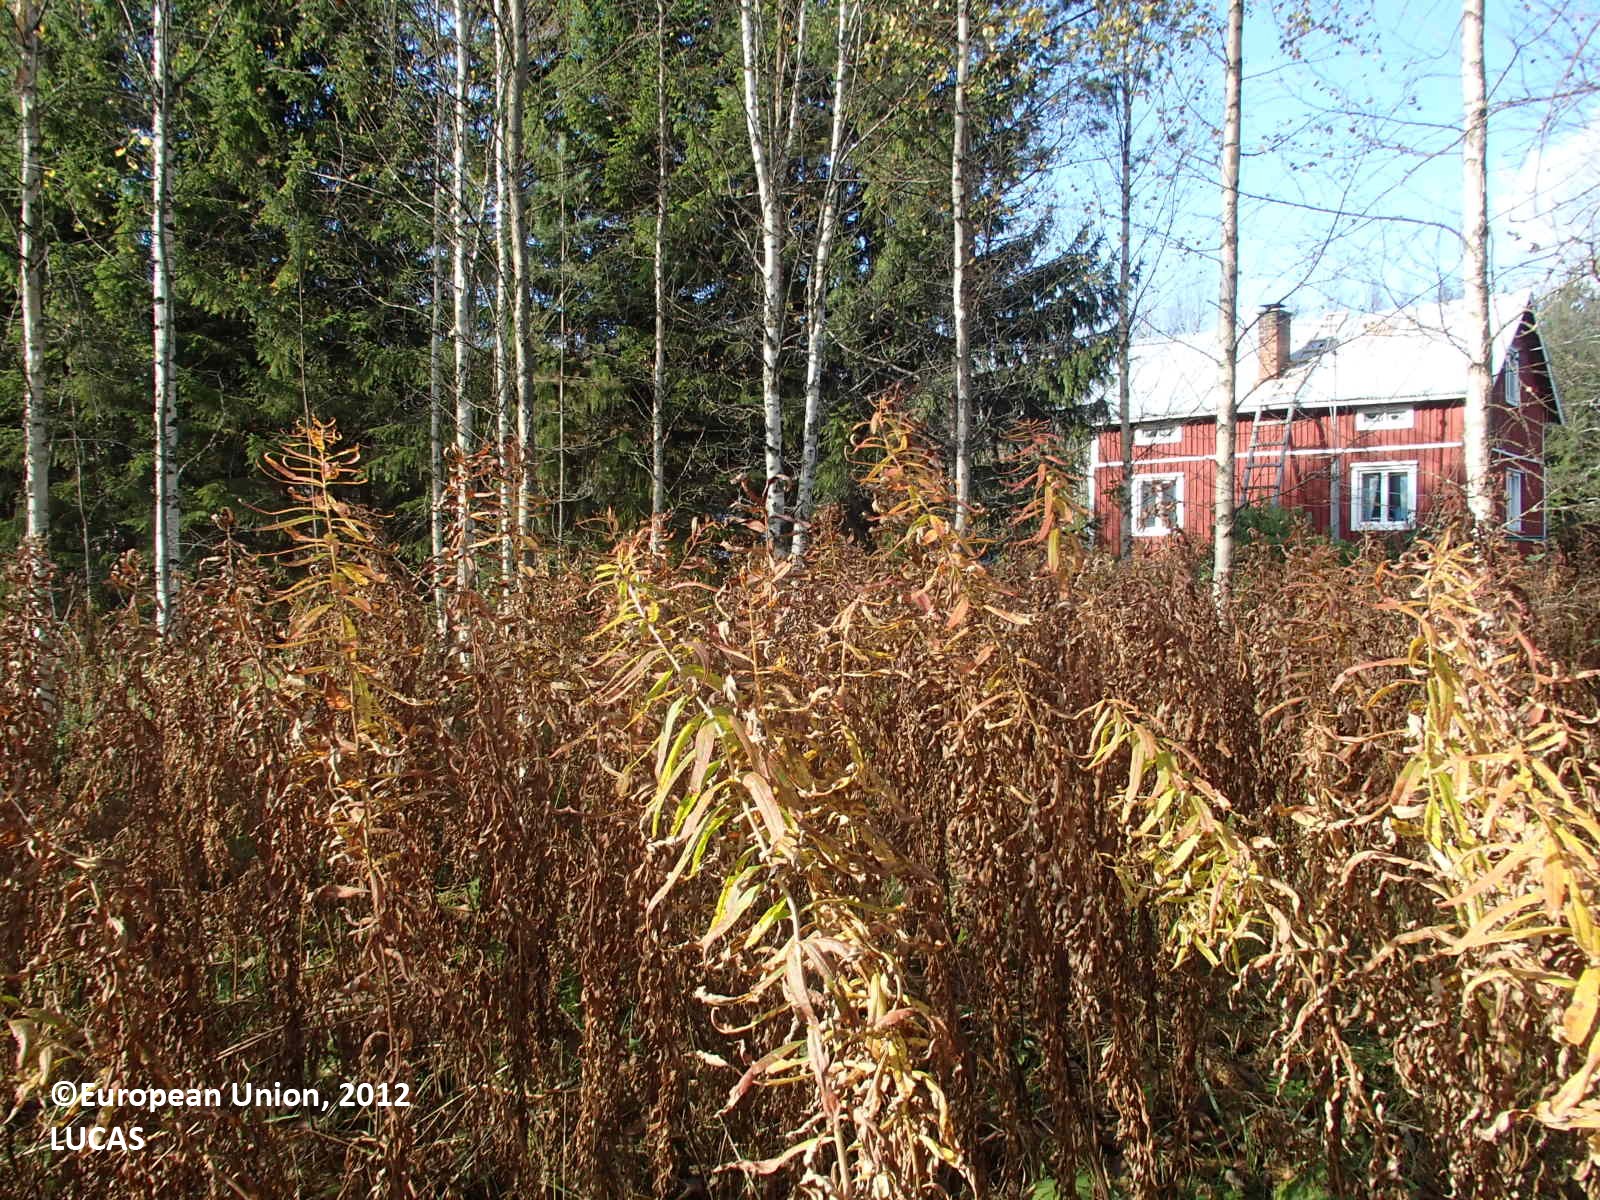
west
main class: Woodland
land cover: Other mixed woodland
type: boreal forest
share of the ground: > 75 %
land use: Forestry
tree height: > 5 m
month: September
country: FI
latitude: 63.6610
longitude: 26.0935
